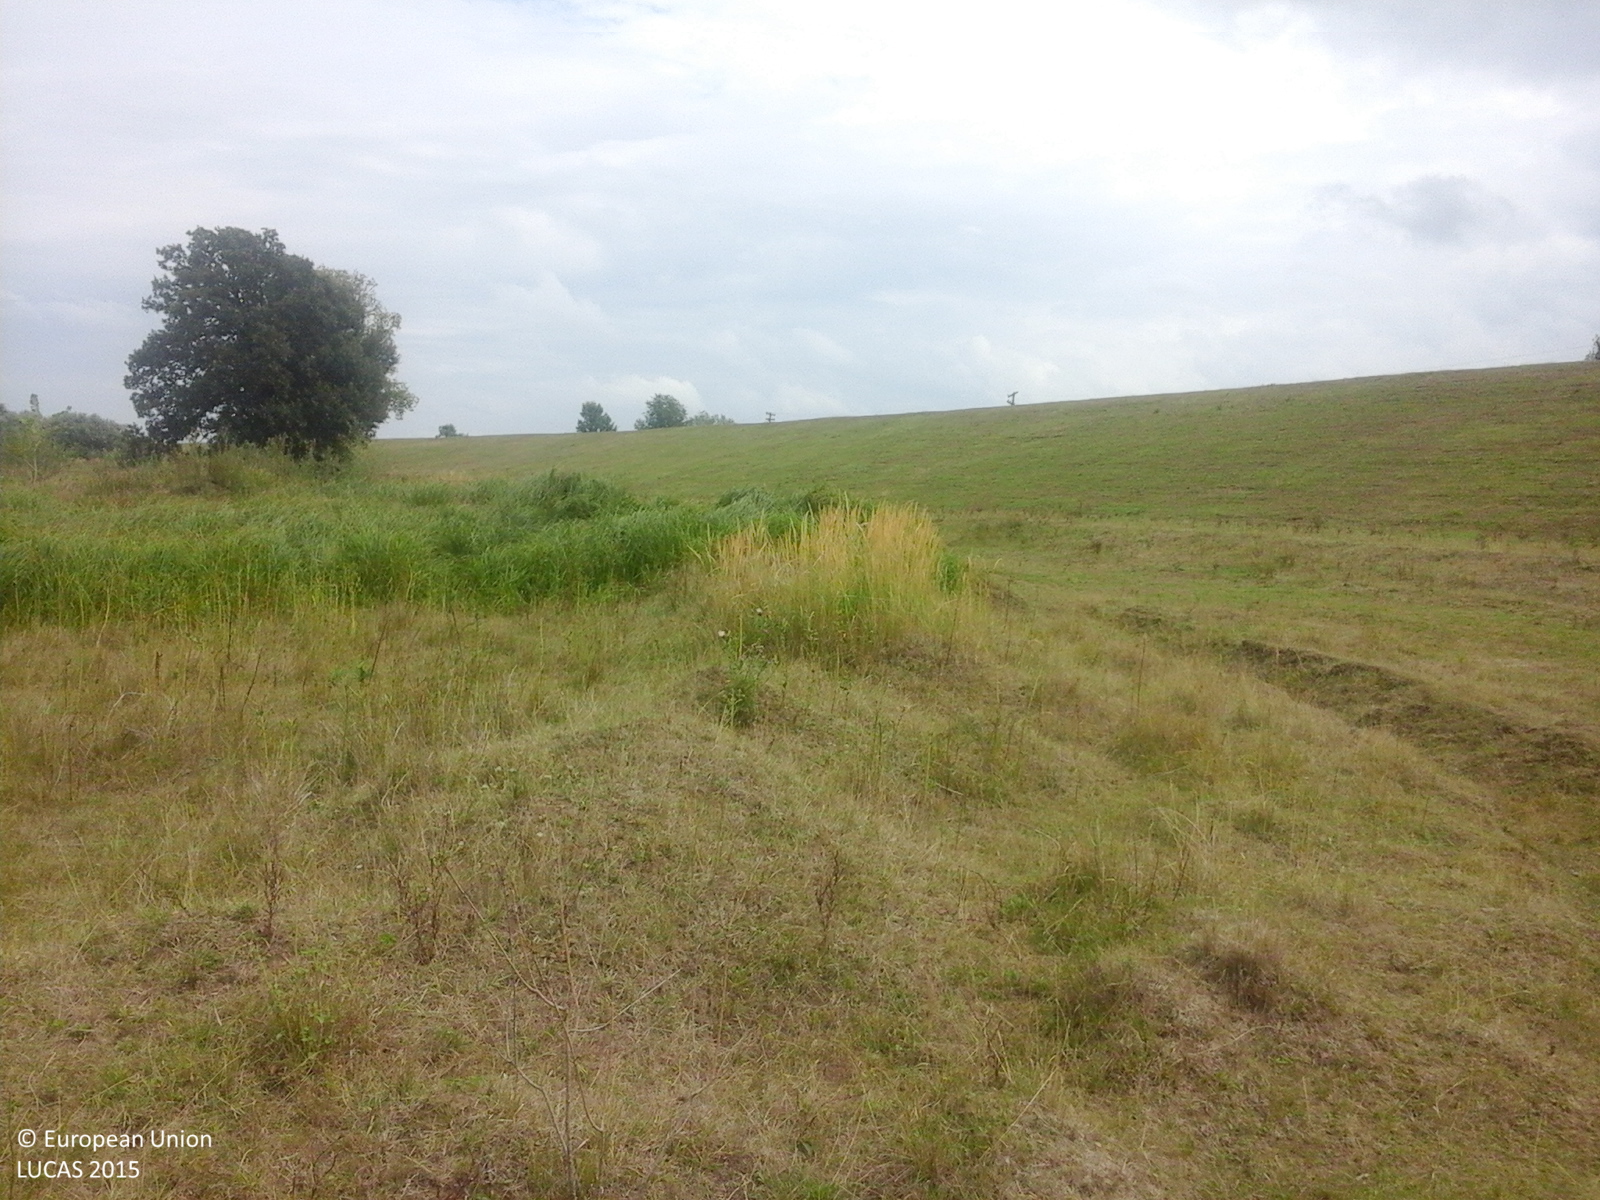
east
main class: Grassland
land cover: Grassland without tree/shrub cover
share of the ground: > 75 %
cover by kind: herbaceous plants 100 %
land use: Agriculture (excluding fallow land and kitchen gardens)
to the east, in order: Grassland without tree/shrub cover; Tracks; Grassland without tree/shrub cover; Electric lines; Grassland without tree/shrub cover; Broadleaved woodland
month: August
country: RO
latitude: 45.4743
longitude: 20.9889
